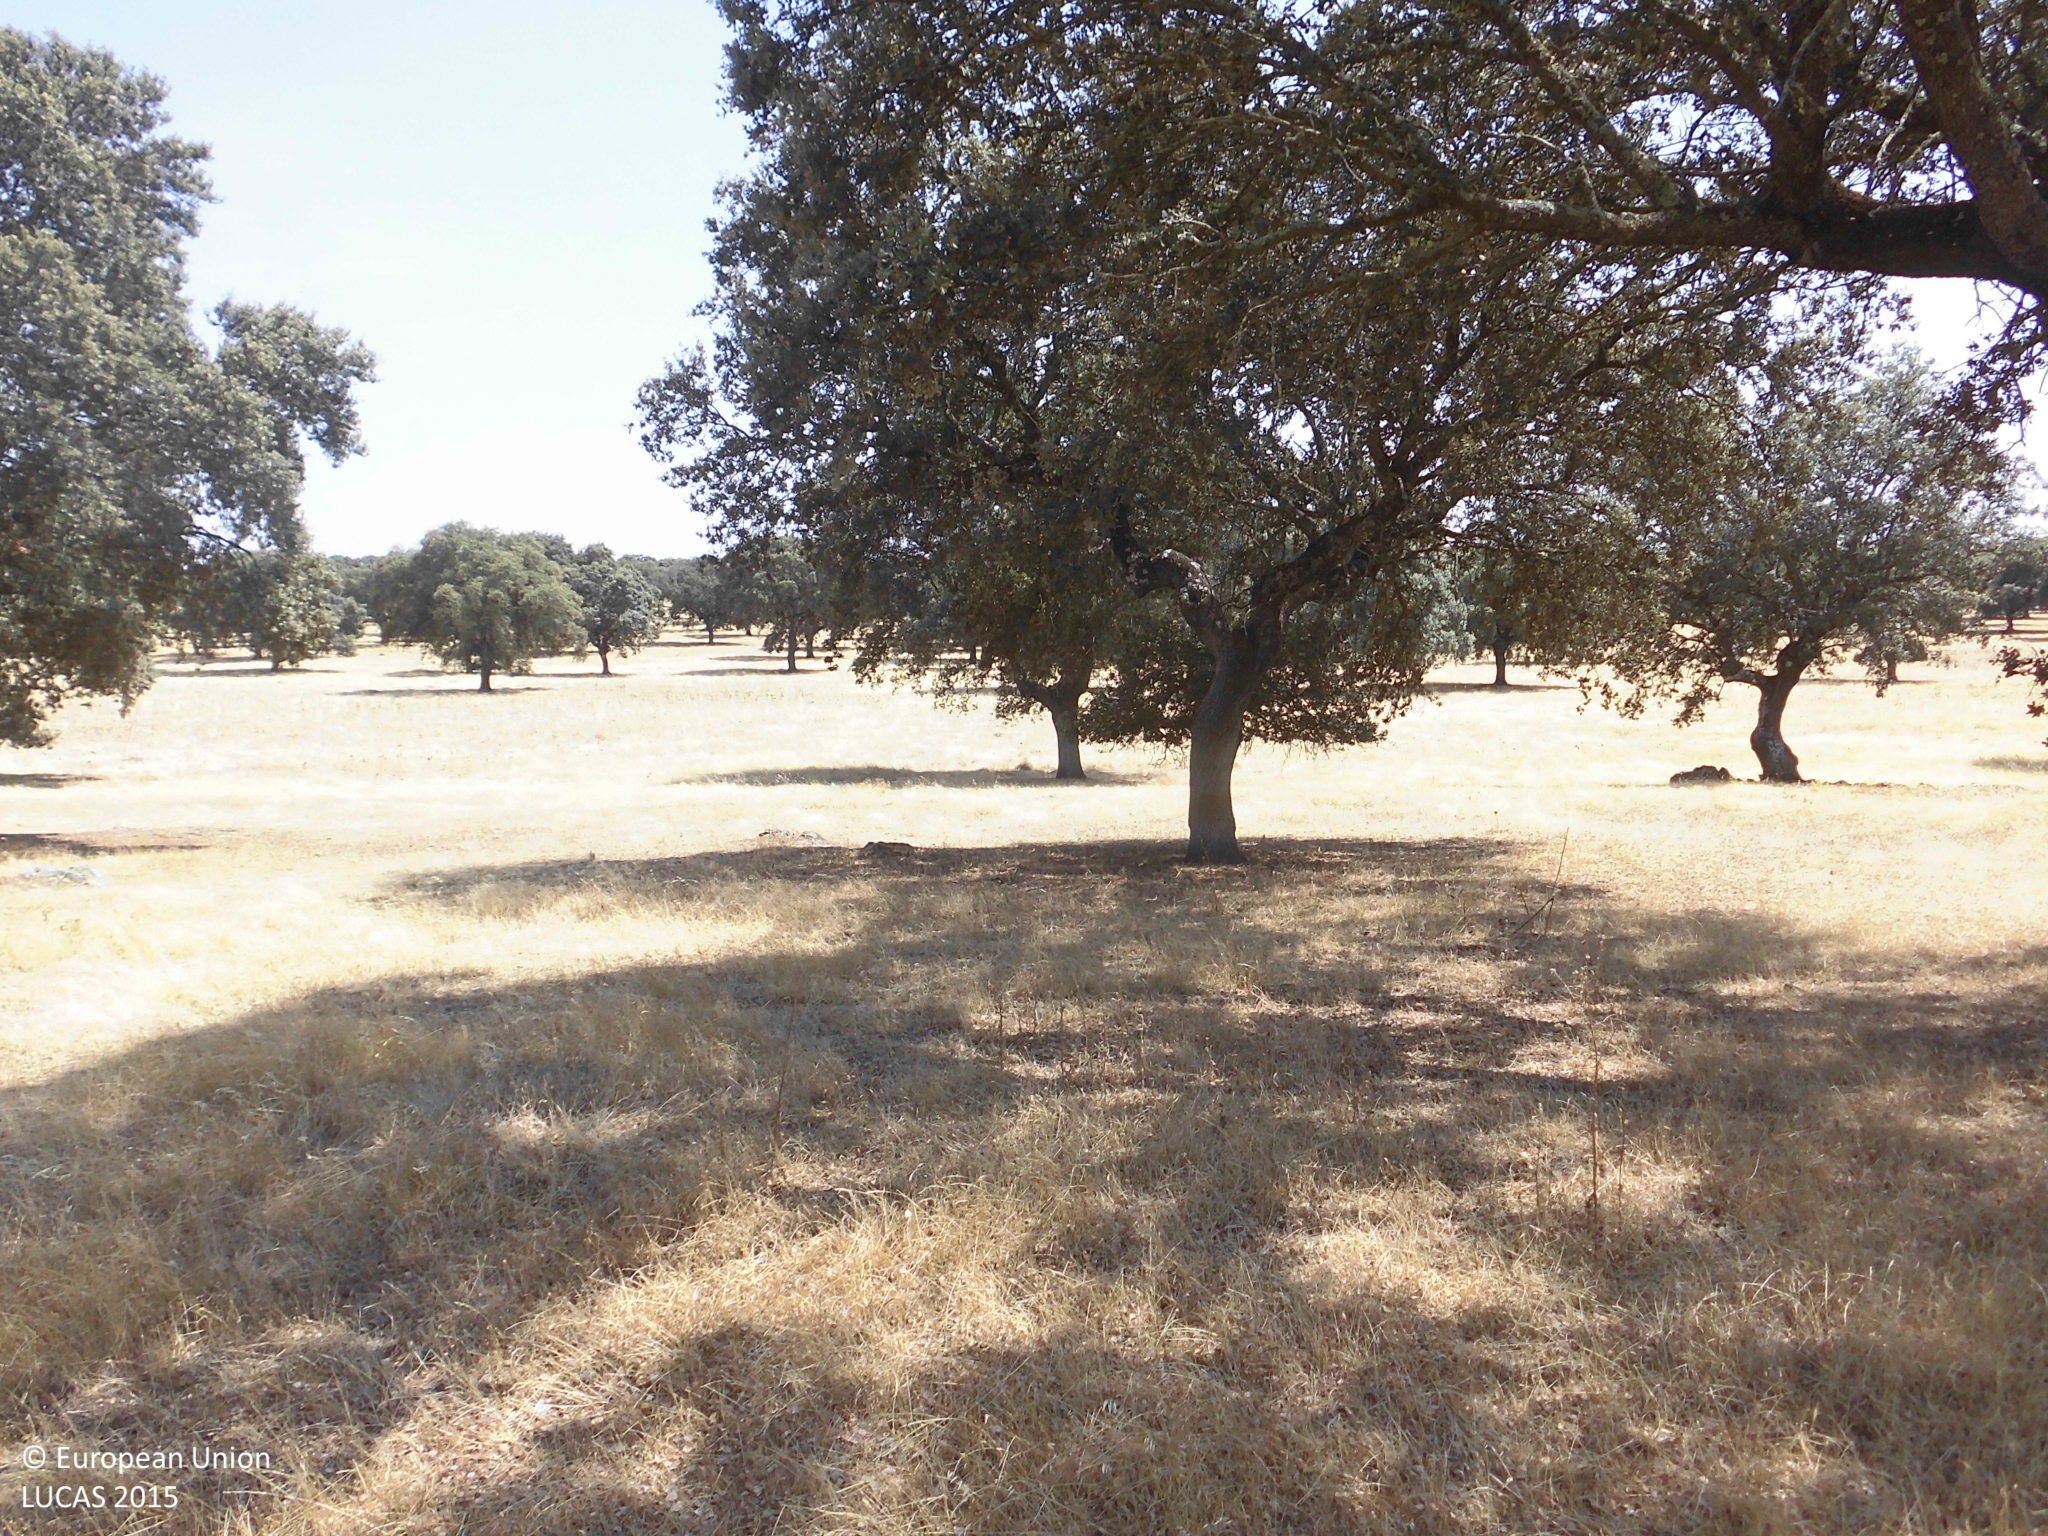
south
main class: Woodland
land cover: Broadleaved woodland
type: broadleaved evergreen forest
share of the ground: 25 - 50 %
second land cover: Grassland without tree/shrub cover
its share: > 75 %
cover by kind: herbaceous plants 70 %, broadleaved forest trees 30 %
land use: Forestry
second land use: Agriculture (excluding fallow land and kitchen gardens)
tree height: > 5 m
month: July
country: ES
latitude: 39.5617
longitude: -5.8300
